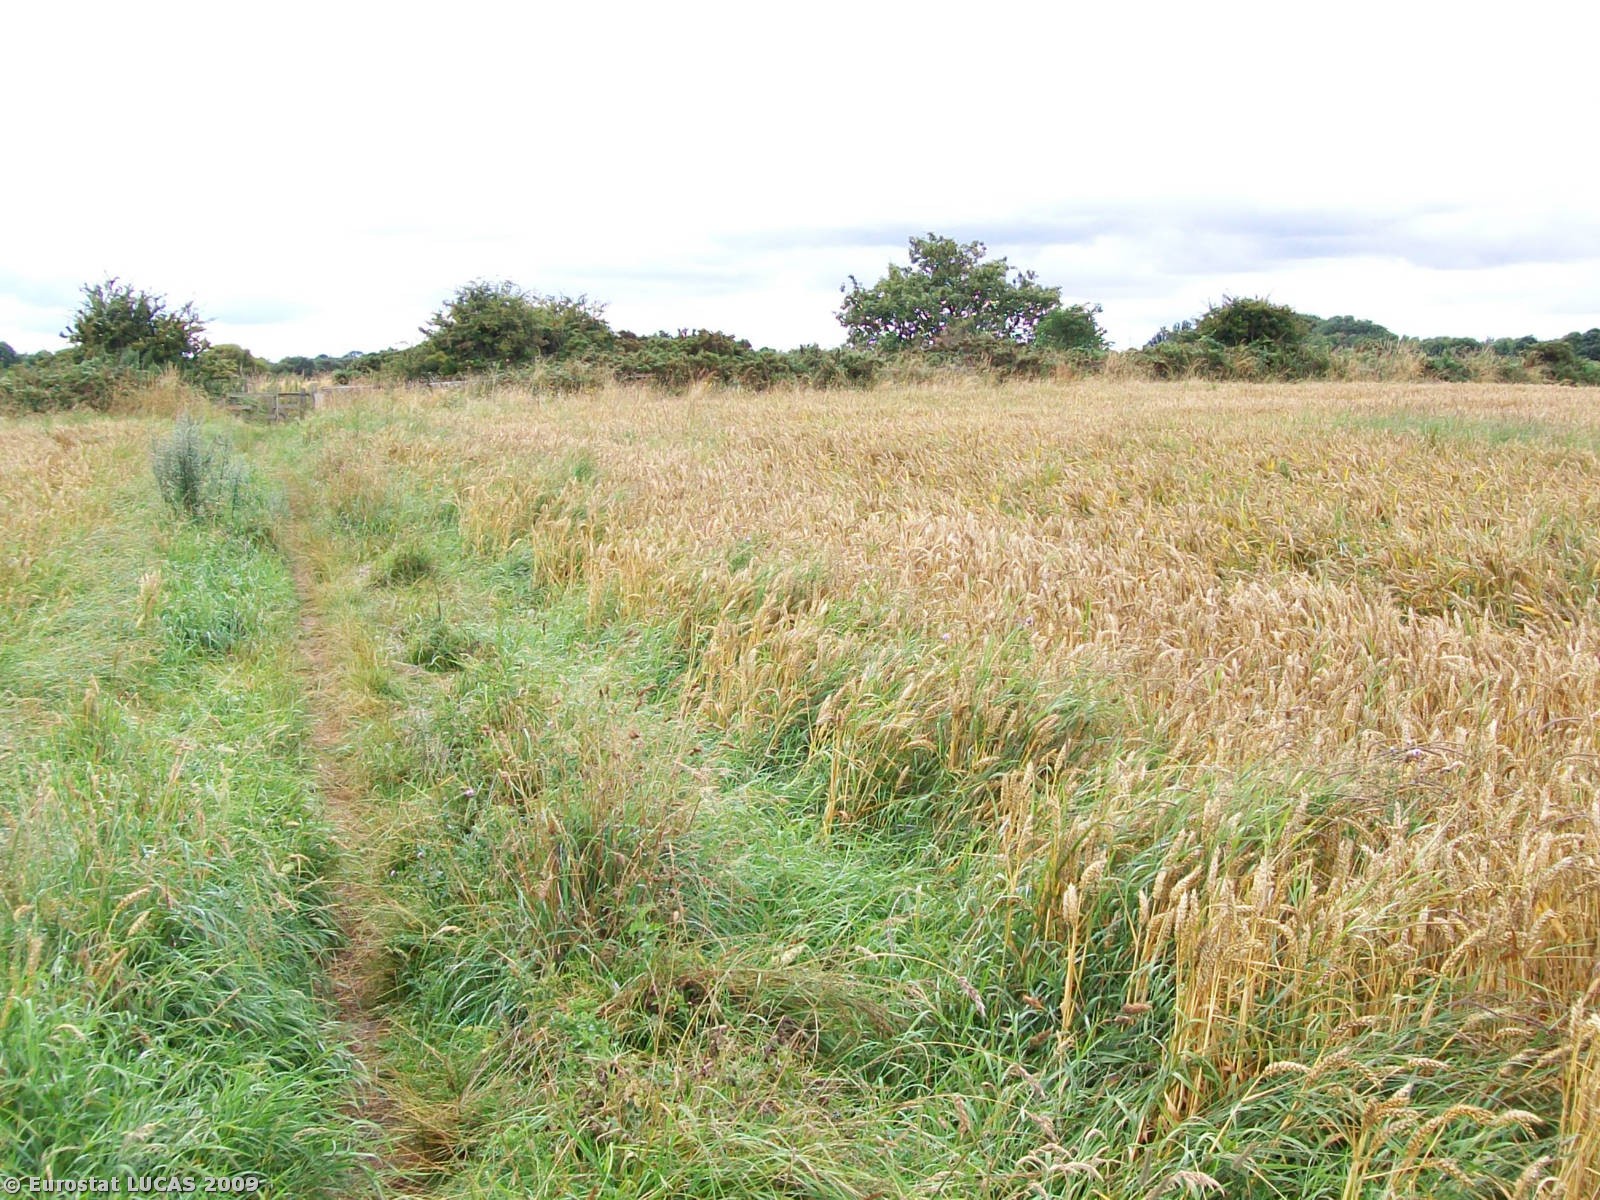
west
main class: Cropland
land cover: Common wheat
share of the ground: > 75 %
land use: Agriculture (excluding fallow land and kitchen gardens)
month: August
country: GB
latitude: 55.0694
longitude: -1.4945
